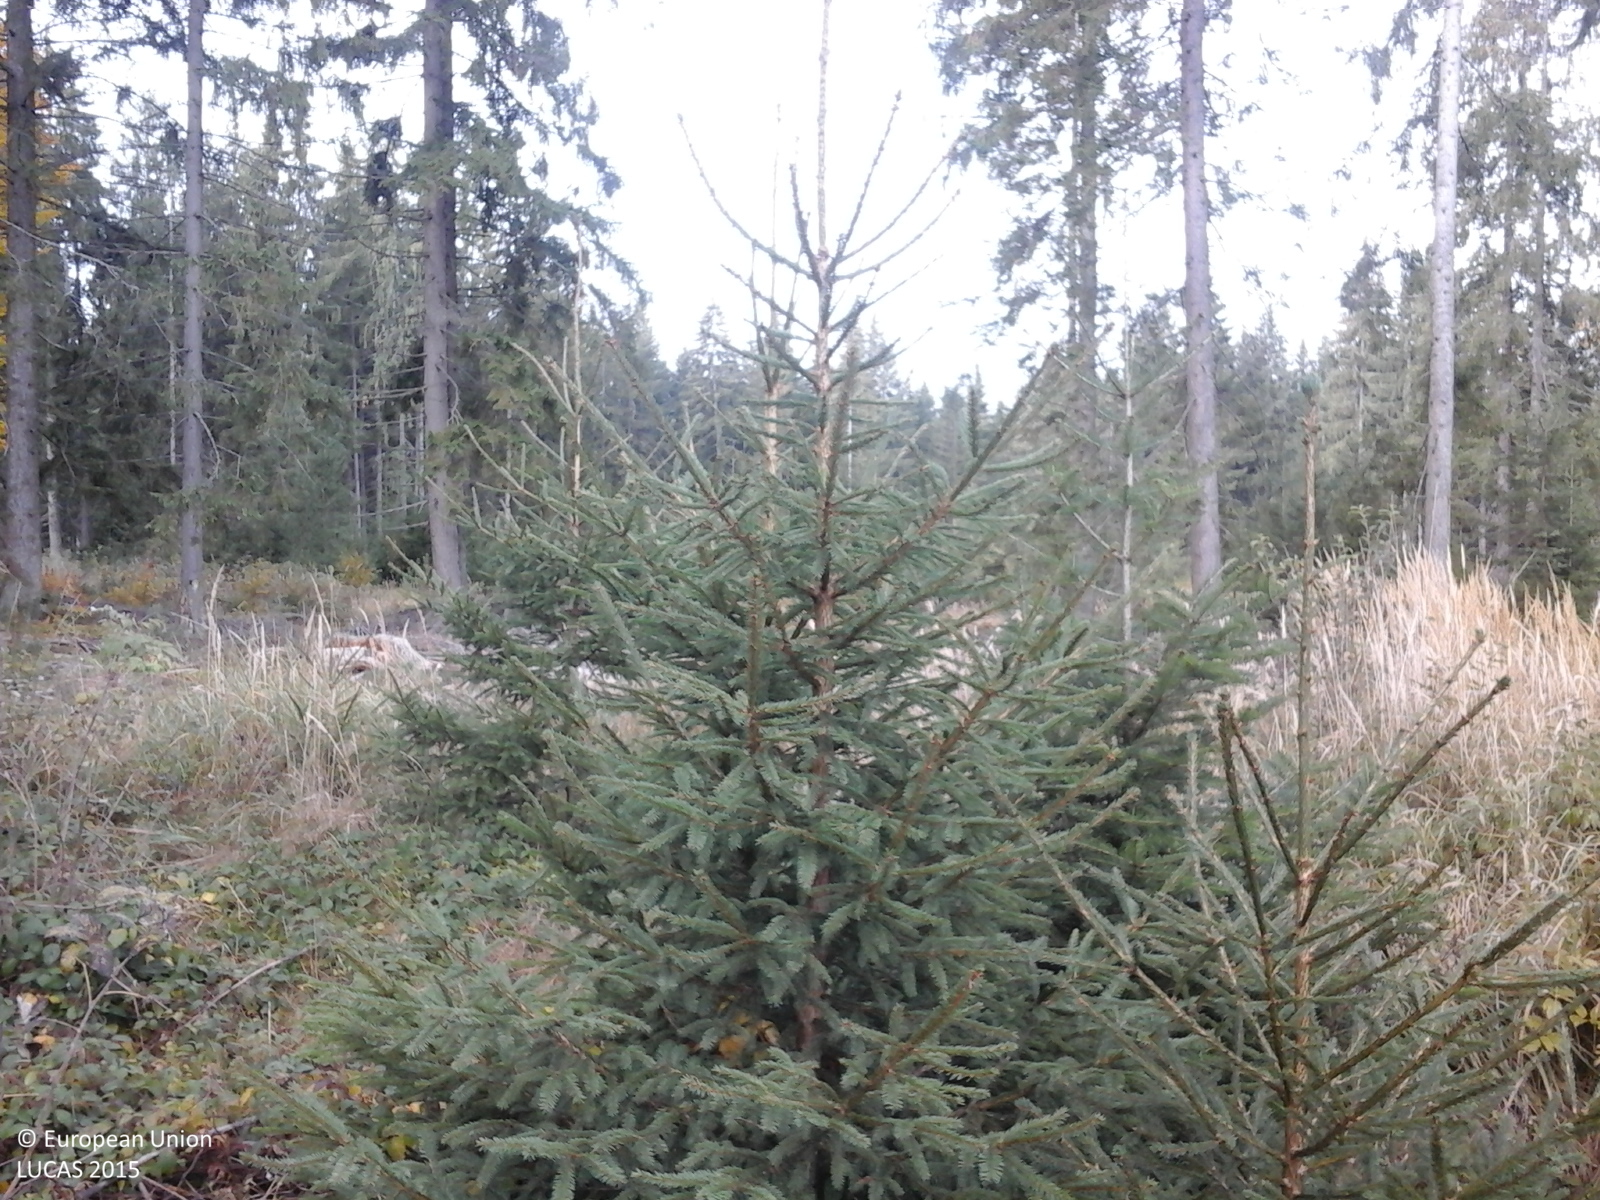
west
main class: Grassland
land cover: Grassland with sparse tree/shrub cover
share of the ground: > 75 %
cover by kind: herbaceous plants 85 %, shrubs 10 %, broadleaved forest trees 5 %
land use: Fallow land
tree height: < 5 m
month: October
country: RO
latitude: 46.4796
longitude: 25.3581
